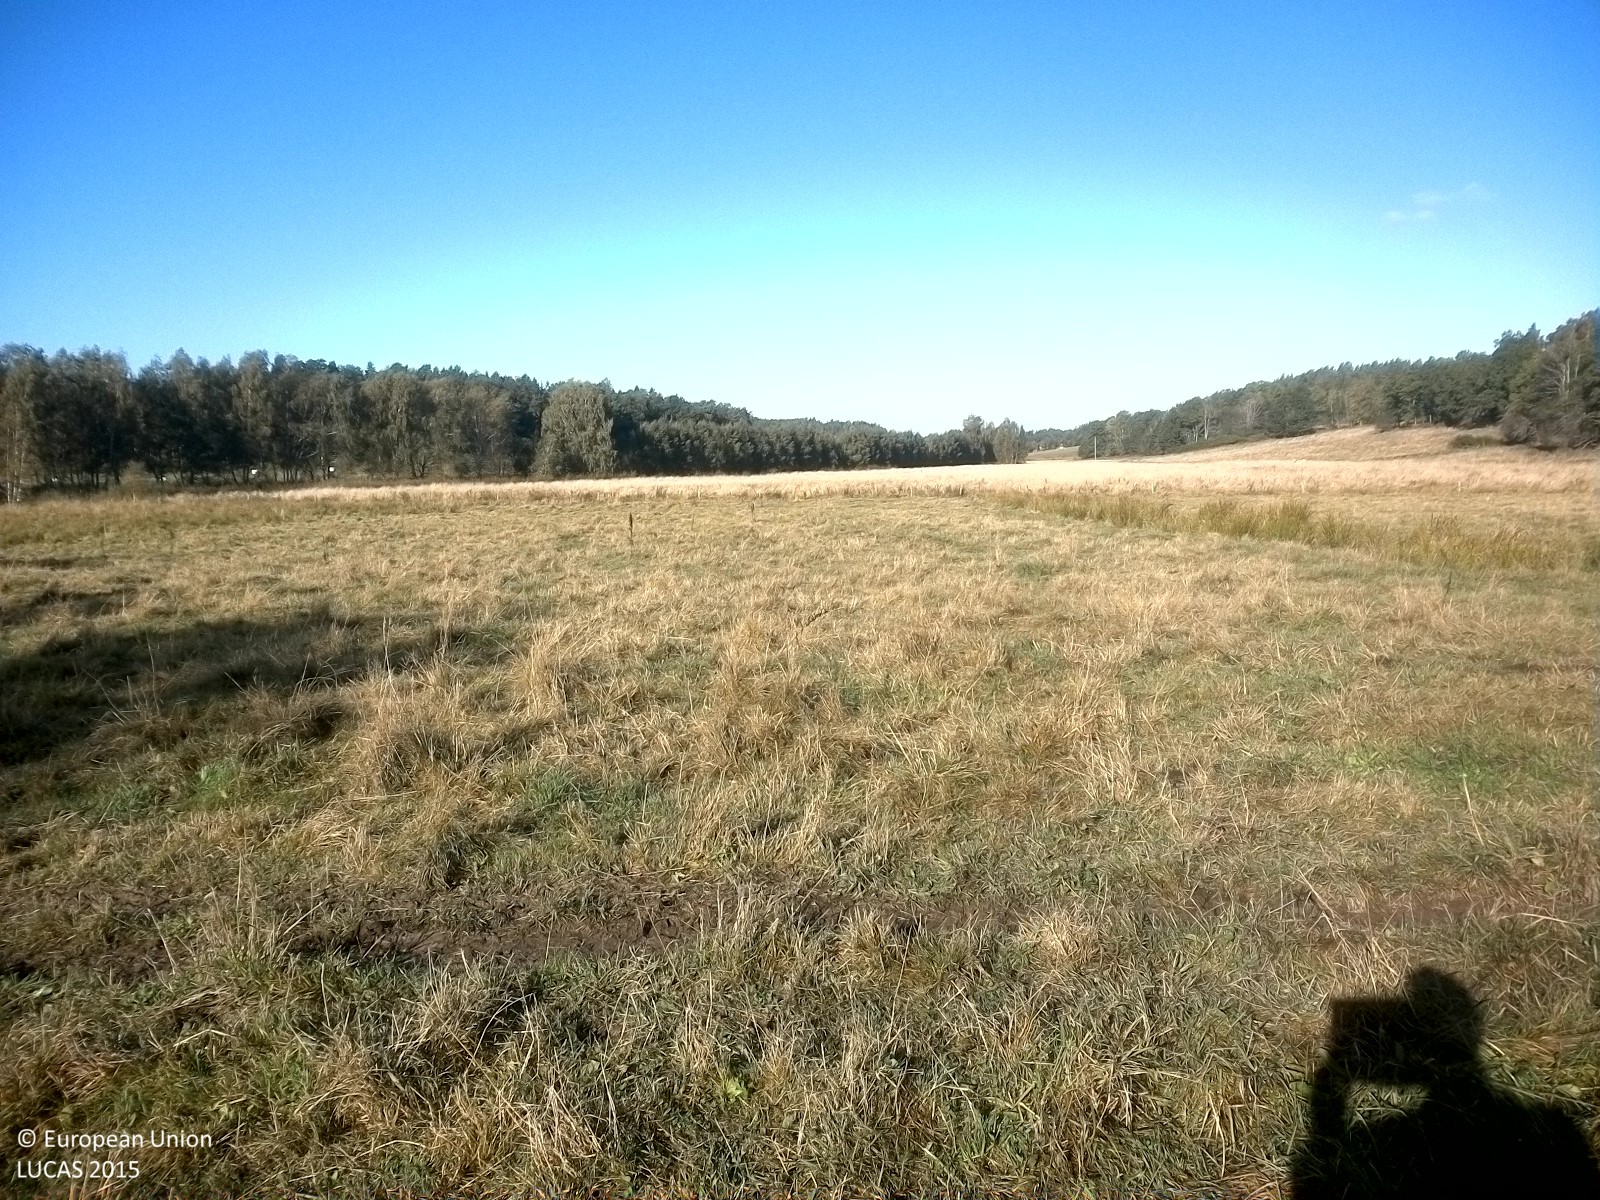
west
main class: Grassland
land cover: Grassland without tree/shrub cover
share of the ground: > 75 %
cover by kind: herbaceous plants 100 %
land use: Agriculture (excluding fallow land and kitchen gardens)
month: September
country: SE
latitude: 58.4465
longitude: 16.7646
